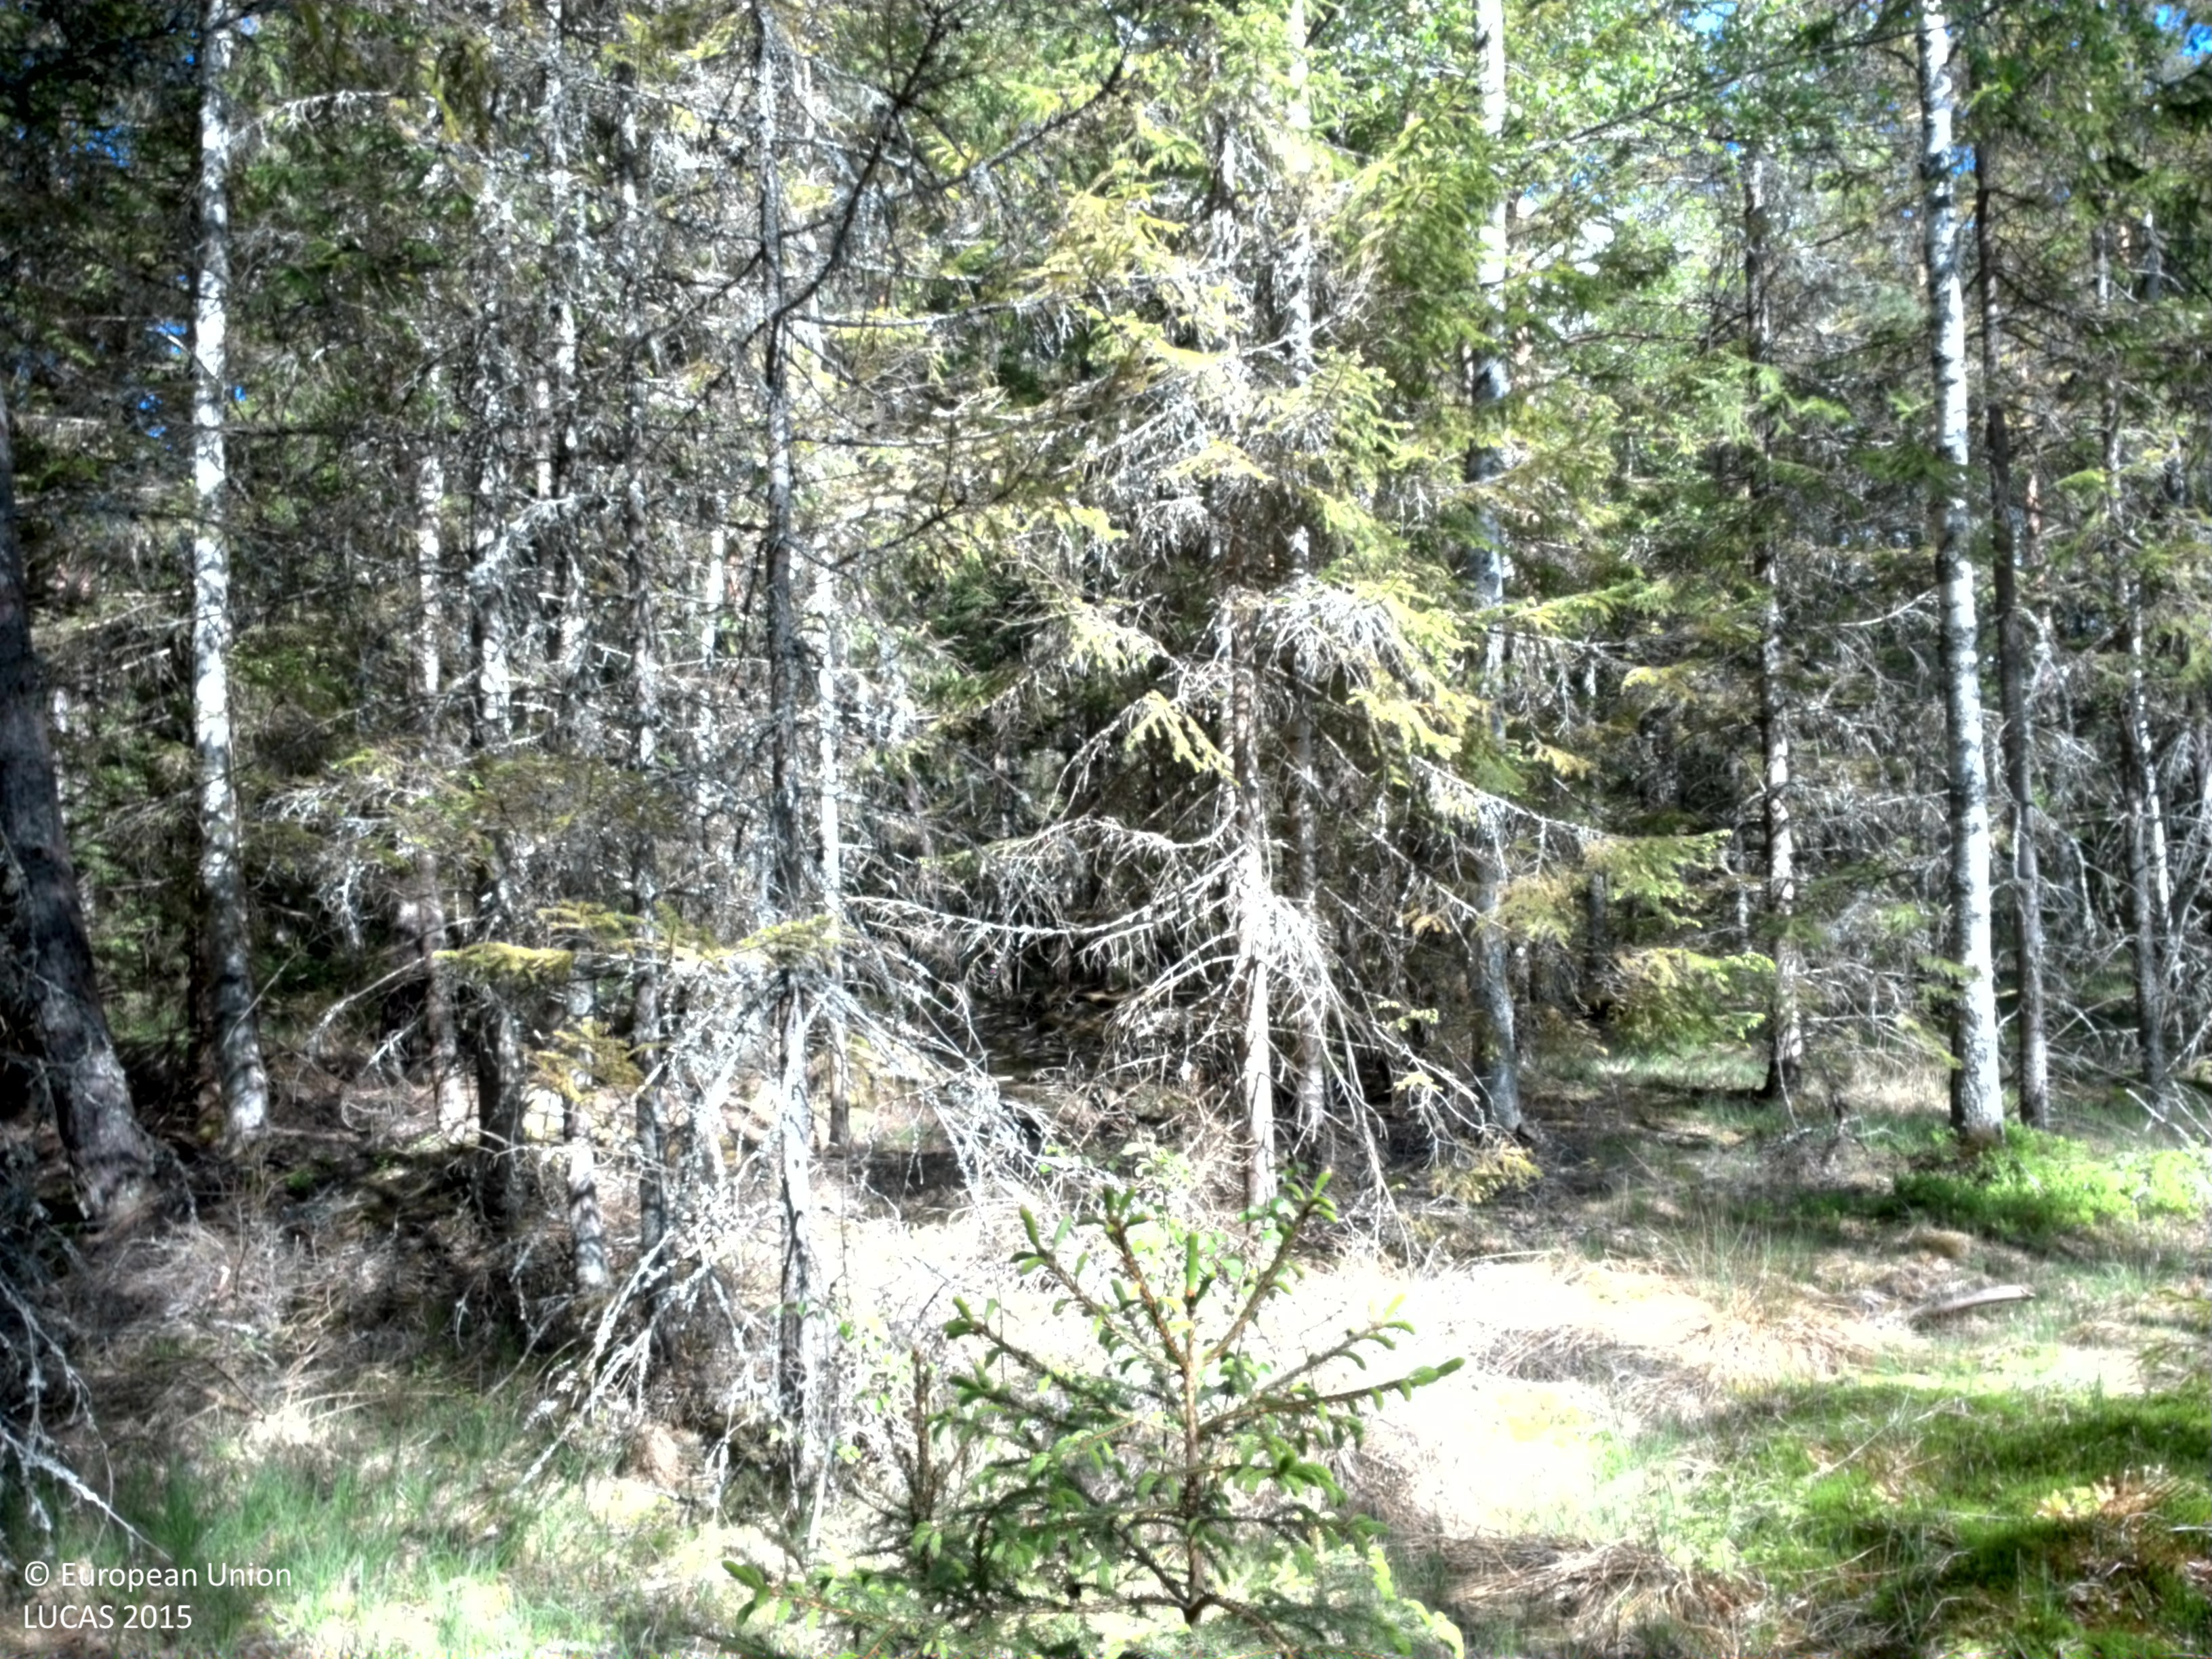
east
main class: Woodland
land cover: Spruce dominated mixed woodland
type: boreal forest
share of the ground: 50 - 75 %
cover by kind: broadleaved forest trees 35 %, herbaceous plants 25 %, lichens and mosses 20 %, coniferous forest trees 15 %, shrubs 5 %
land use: Forestry
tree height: > 5 m
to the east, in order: Spruce dominated mixed woodland; Ditches and canals; Pine dominated mixed woodland; Ditches and canals; Pine dominated coniferous woodland; Spruce dominated mixed woodland; Broadleaved woodland; Shrubland with sparse tree cover; Paved roads, cycling and walking lanes; Lines of trees; Fences; Broadleaved woodland; Grassland with sparse tree/shrub cover; Fences; Broadleaved woodland; Grass margins; Paved roads, cycling and walking lanes
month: May
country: SE
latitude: 57.3476
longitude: 15.9640
